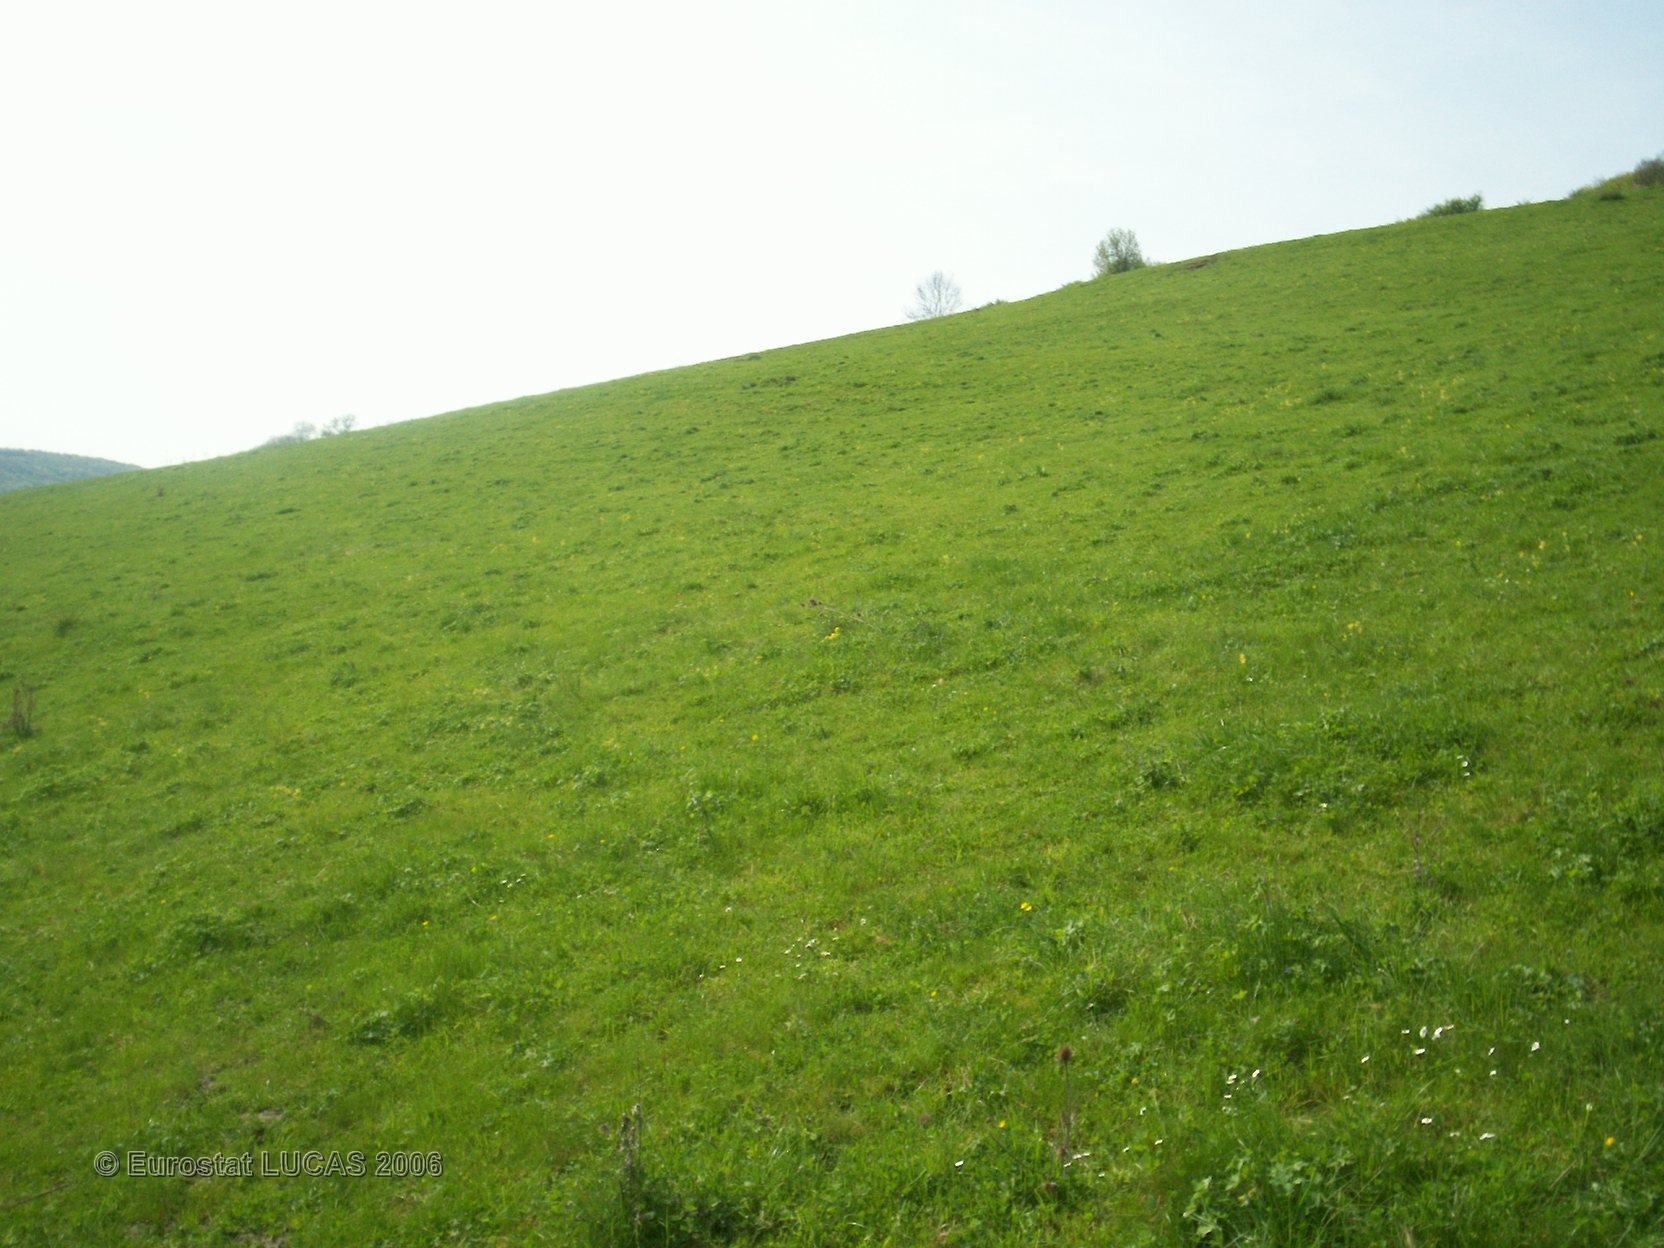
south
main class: Grassland
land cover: Grassland without tree/shrub cover
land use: Agriculture (excluding fallow land and kitchen gardens)
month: May
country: FR
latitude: 47.4446
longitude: 4.6552
